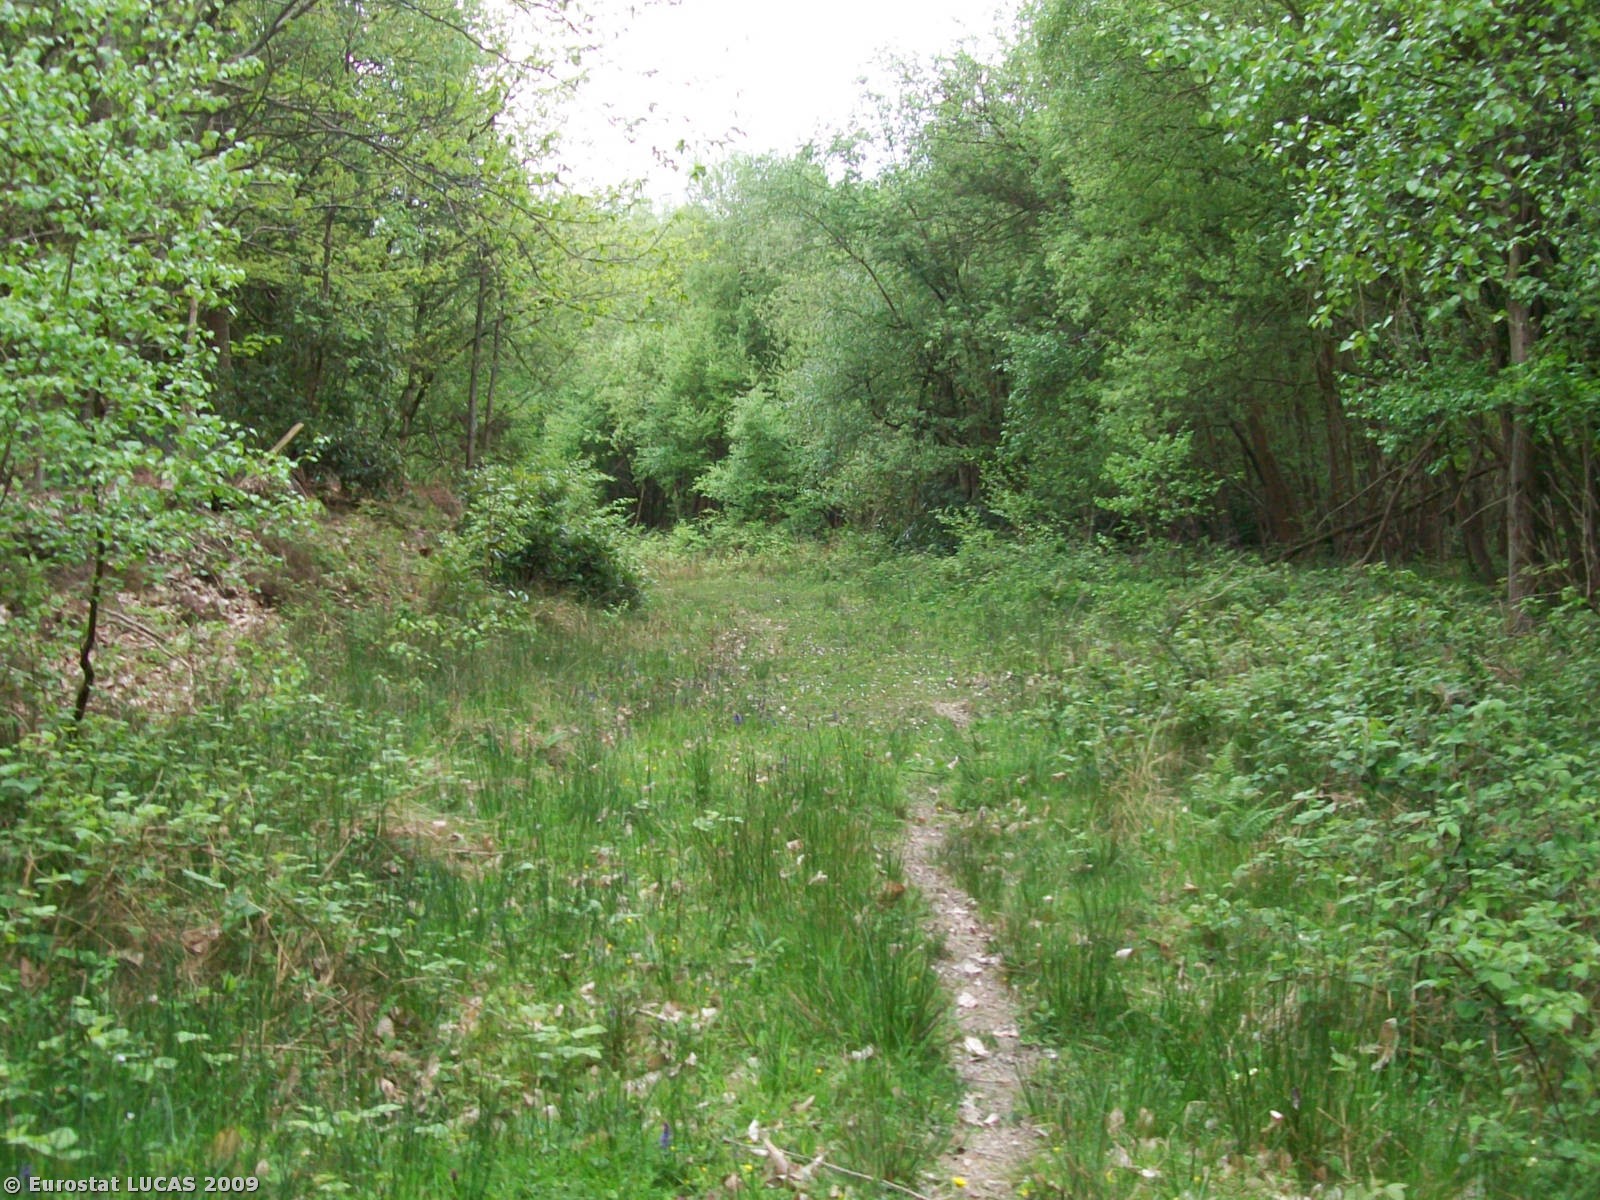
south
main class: Woodland
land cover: Mixed woodland
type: mesophytic deciduous forest
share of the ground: > 75 %
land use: Forestry
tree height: > 5 m
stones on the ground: < 10 %
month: May
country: GB
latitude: 51.1125
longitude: 0.3286
